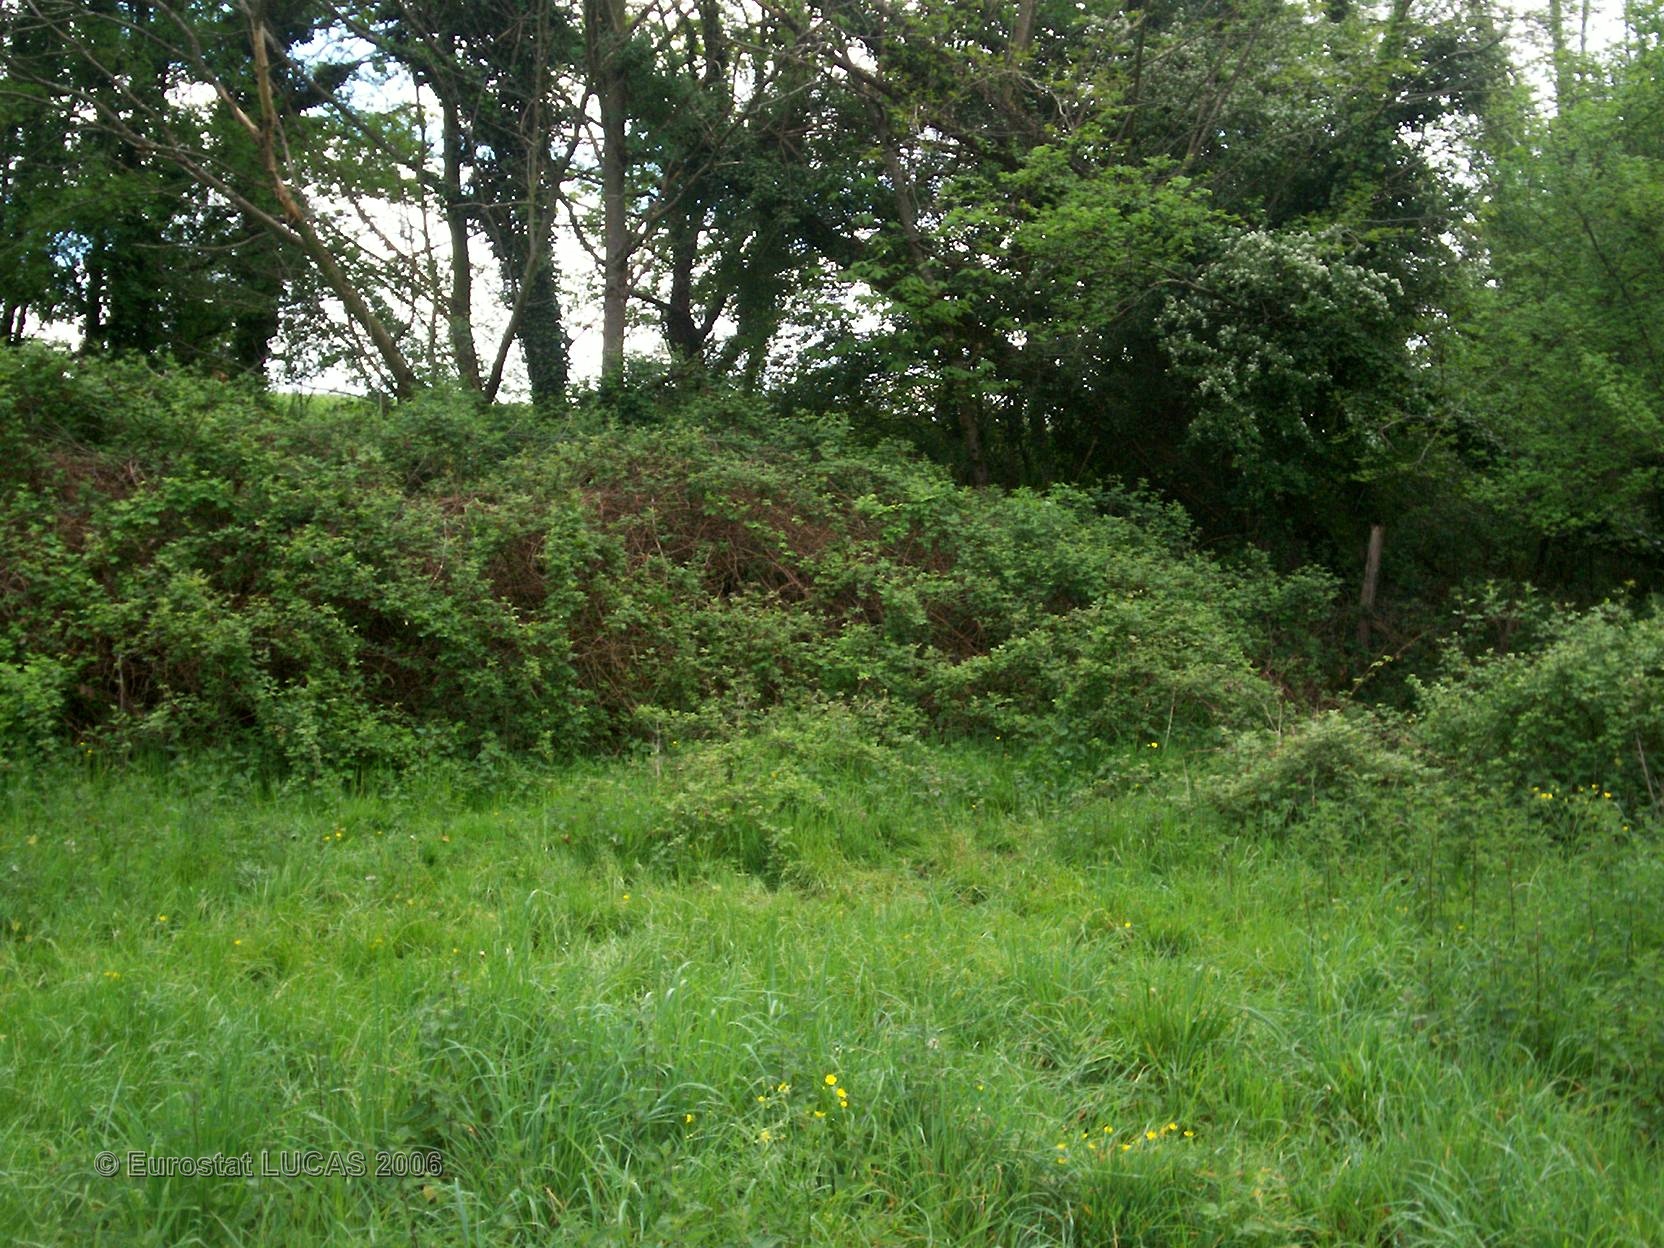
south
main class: Grassland
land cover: Grassland without tree/shrub cover
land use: Agriculture (excluding fallow land and kitchen gardens)
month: May
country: FR
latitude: 45.9771
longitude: 0.4461
